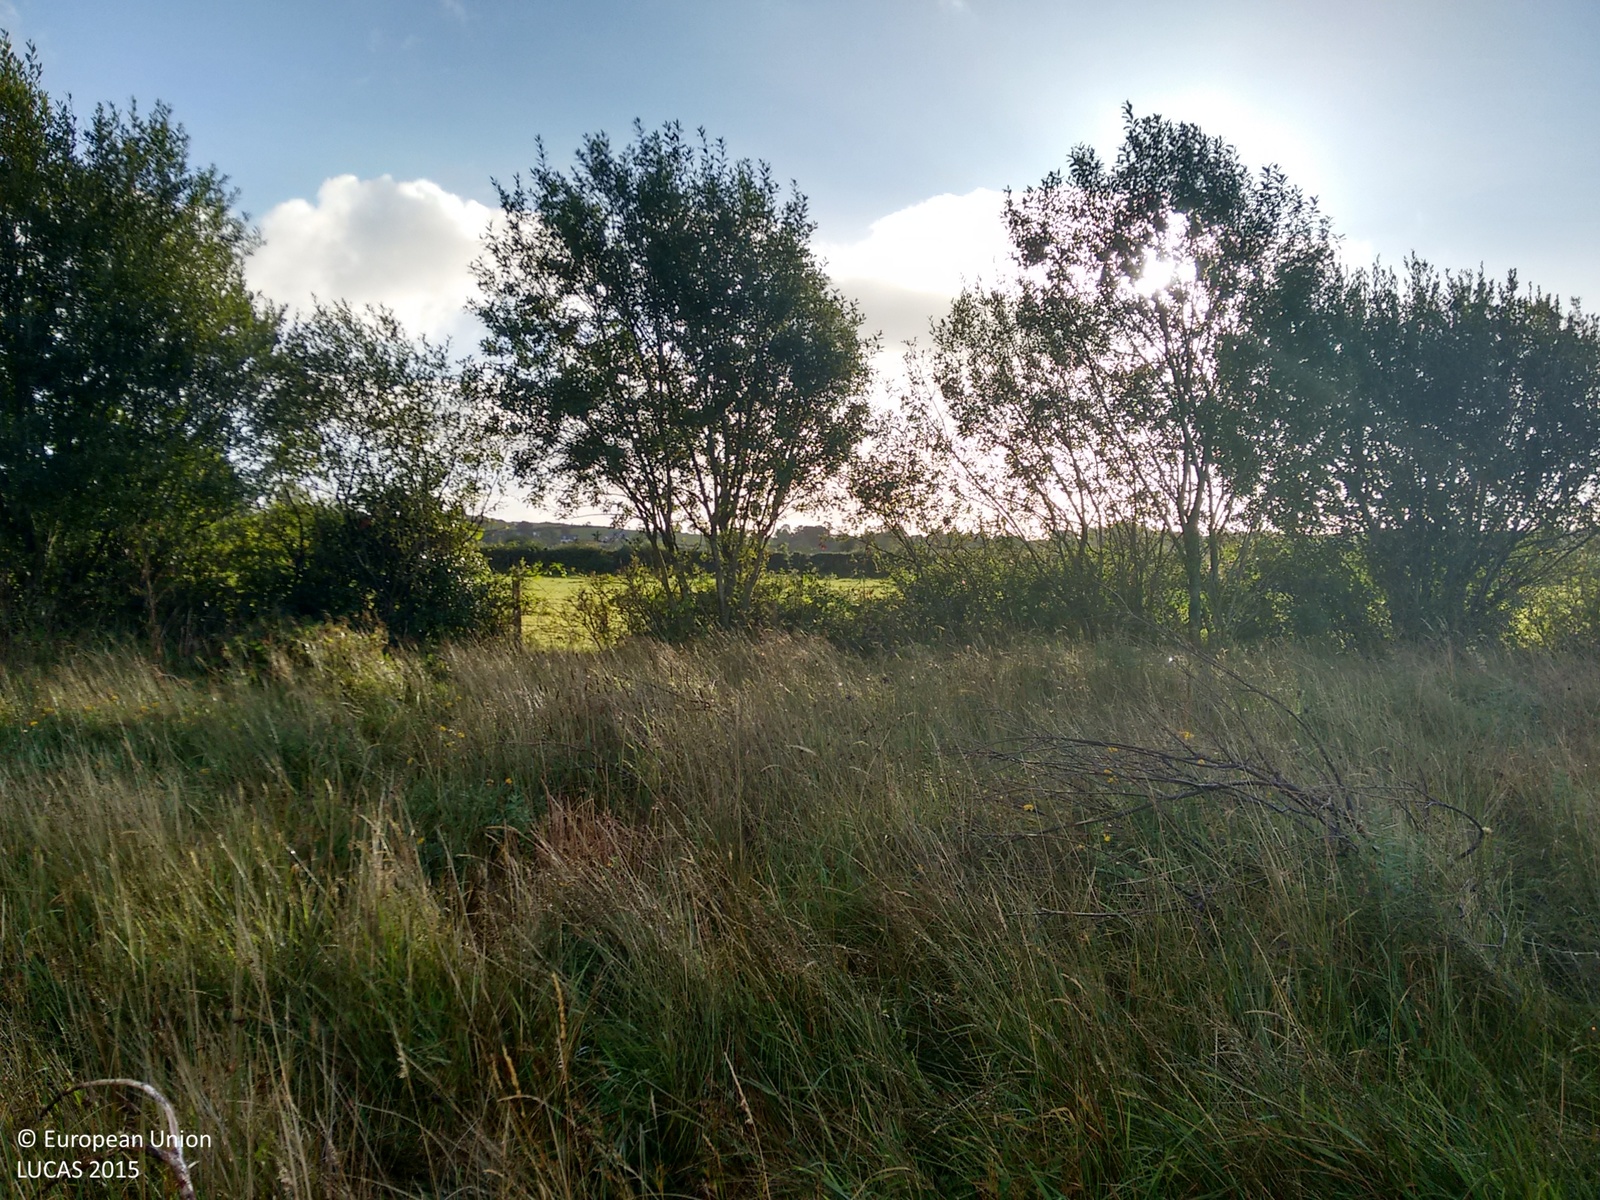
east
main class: Grassland
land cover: Spontaneously vegetated surfaces
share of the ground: > 75 %
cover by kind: herbaceous plants 100 %
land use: Agriculture (excluding fallow land and kitchen gardens)
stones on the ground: < 10 %
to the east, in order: Spontaneously vegetated surfaces; Managed hedges; Fences; Grassland without tree/shrub cover; Fences; Abandoned hedges; Grassland without tree/shrub cover; Managed hedges; Fences; Grassland without tree/shrub cover
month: September
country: IE
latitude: 55.0254
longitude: -7.6315
